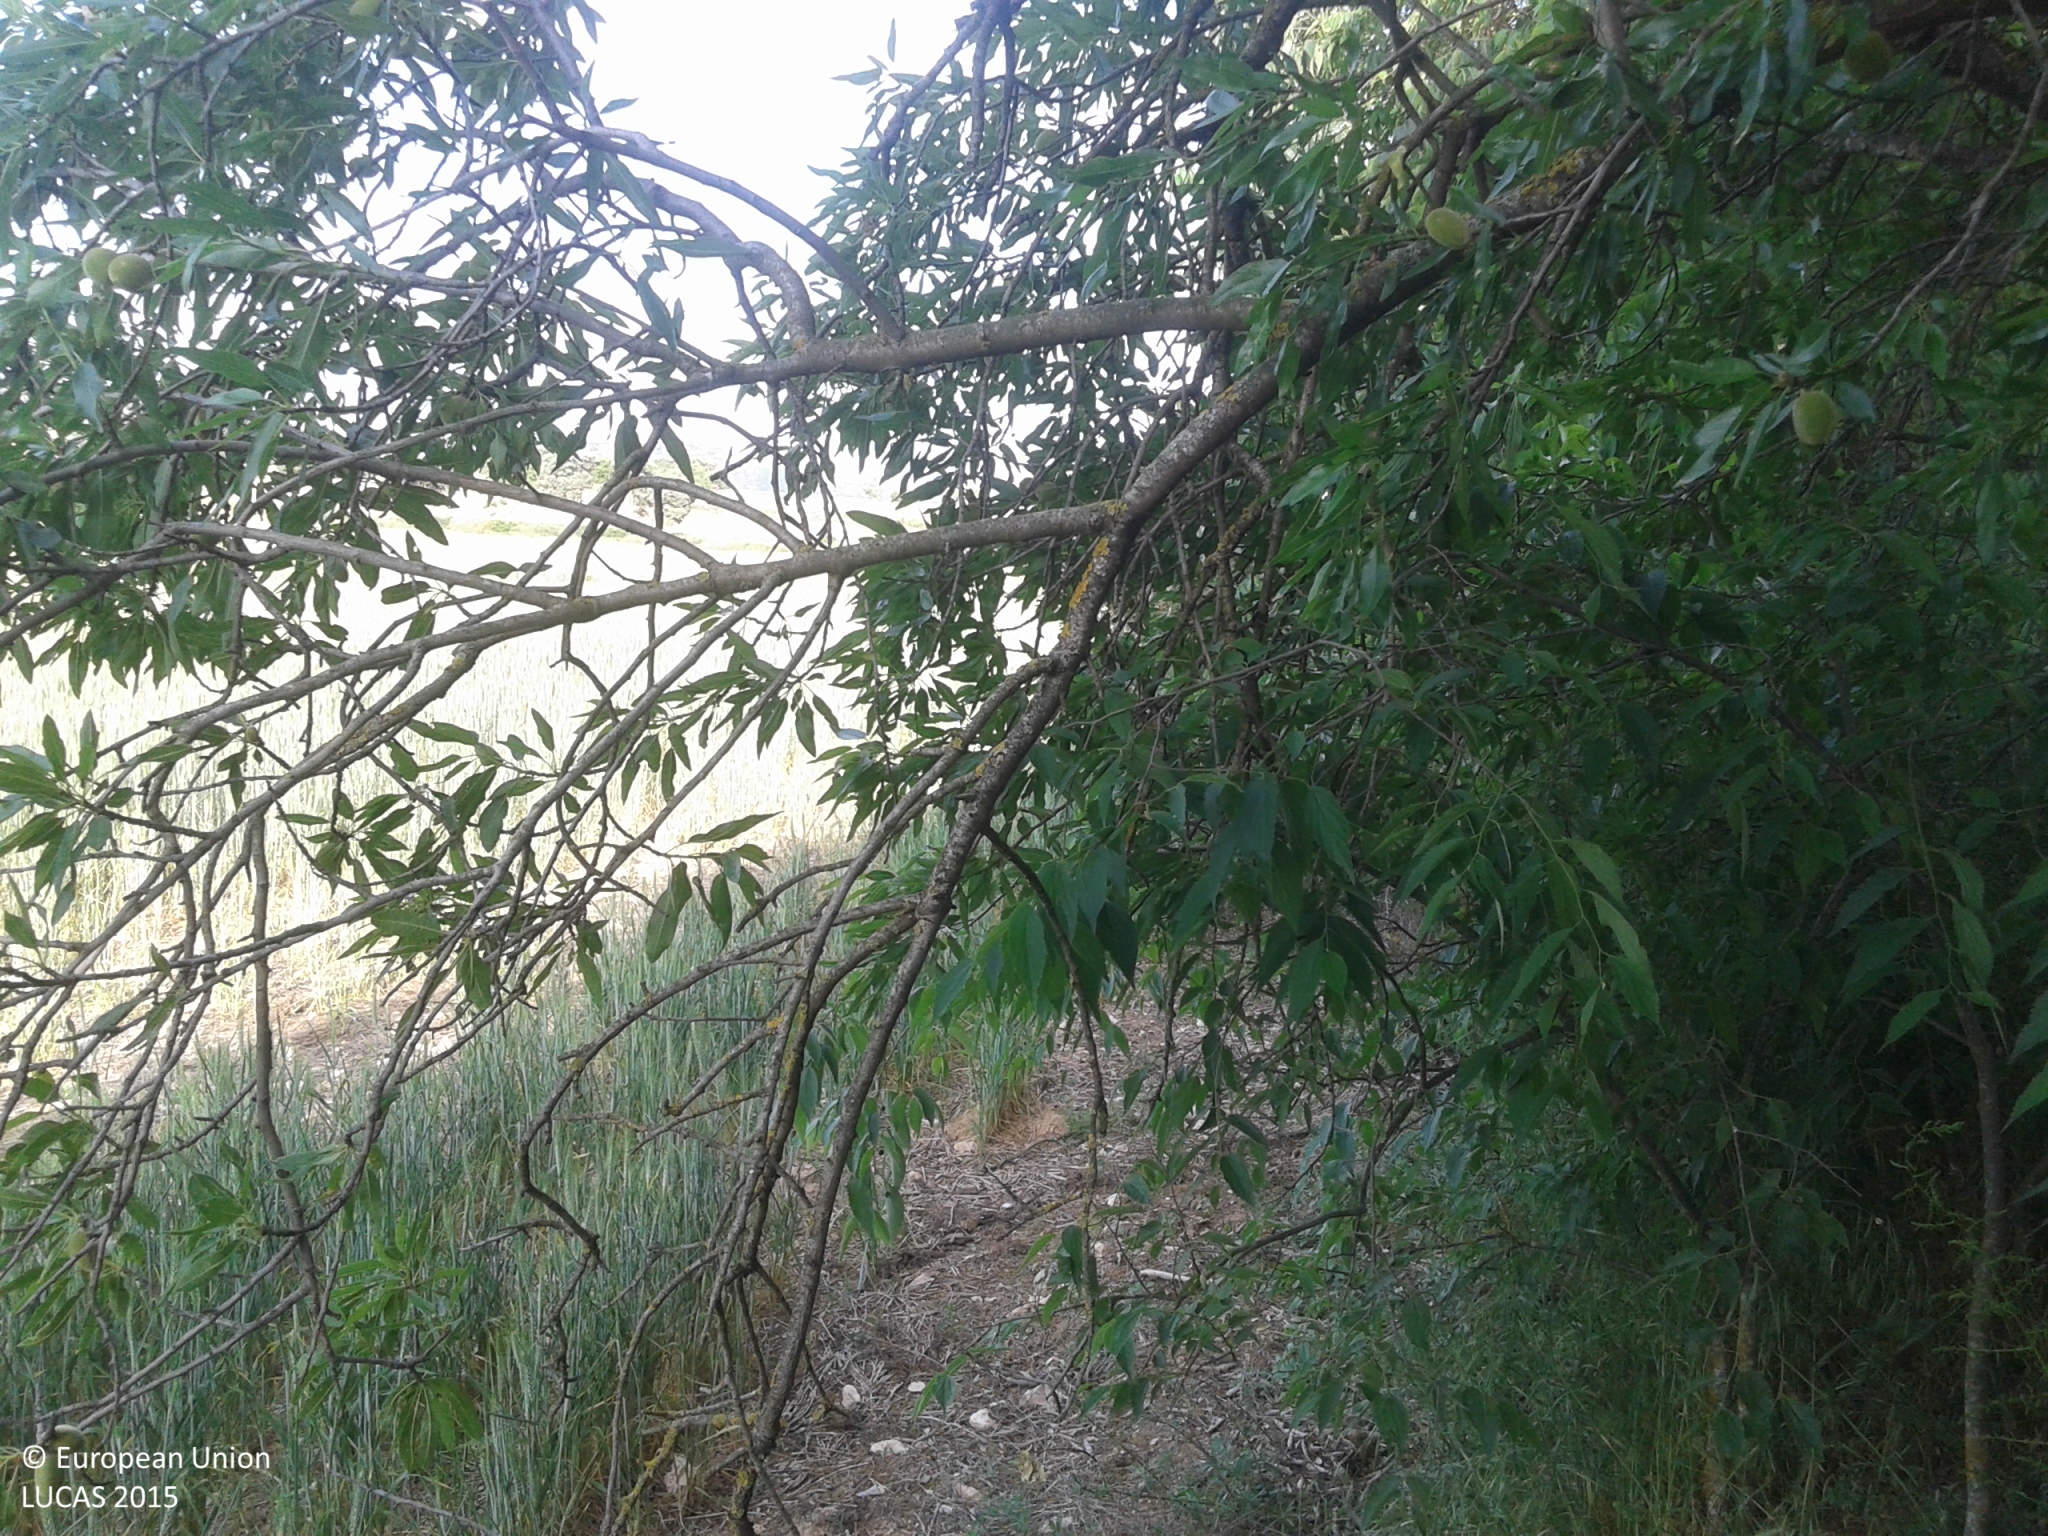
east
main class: Woodland
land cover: Broadleaved woodland
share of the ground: > 75 %
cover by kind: broadleaved forest trees 90 %, shrubs 5 %, herbaceous plants 5 %
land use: Semi-natural and natural areas not in use
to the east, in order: Broadleaved woodland; Common wheat; Grass margins; Barley; Grass margins; Tracks; Grass margins; Groves; Barley
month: May
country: ES
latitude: 41.8371
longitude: 0.6292
